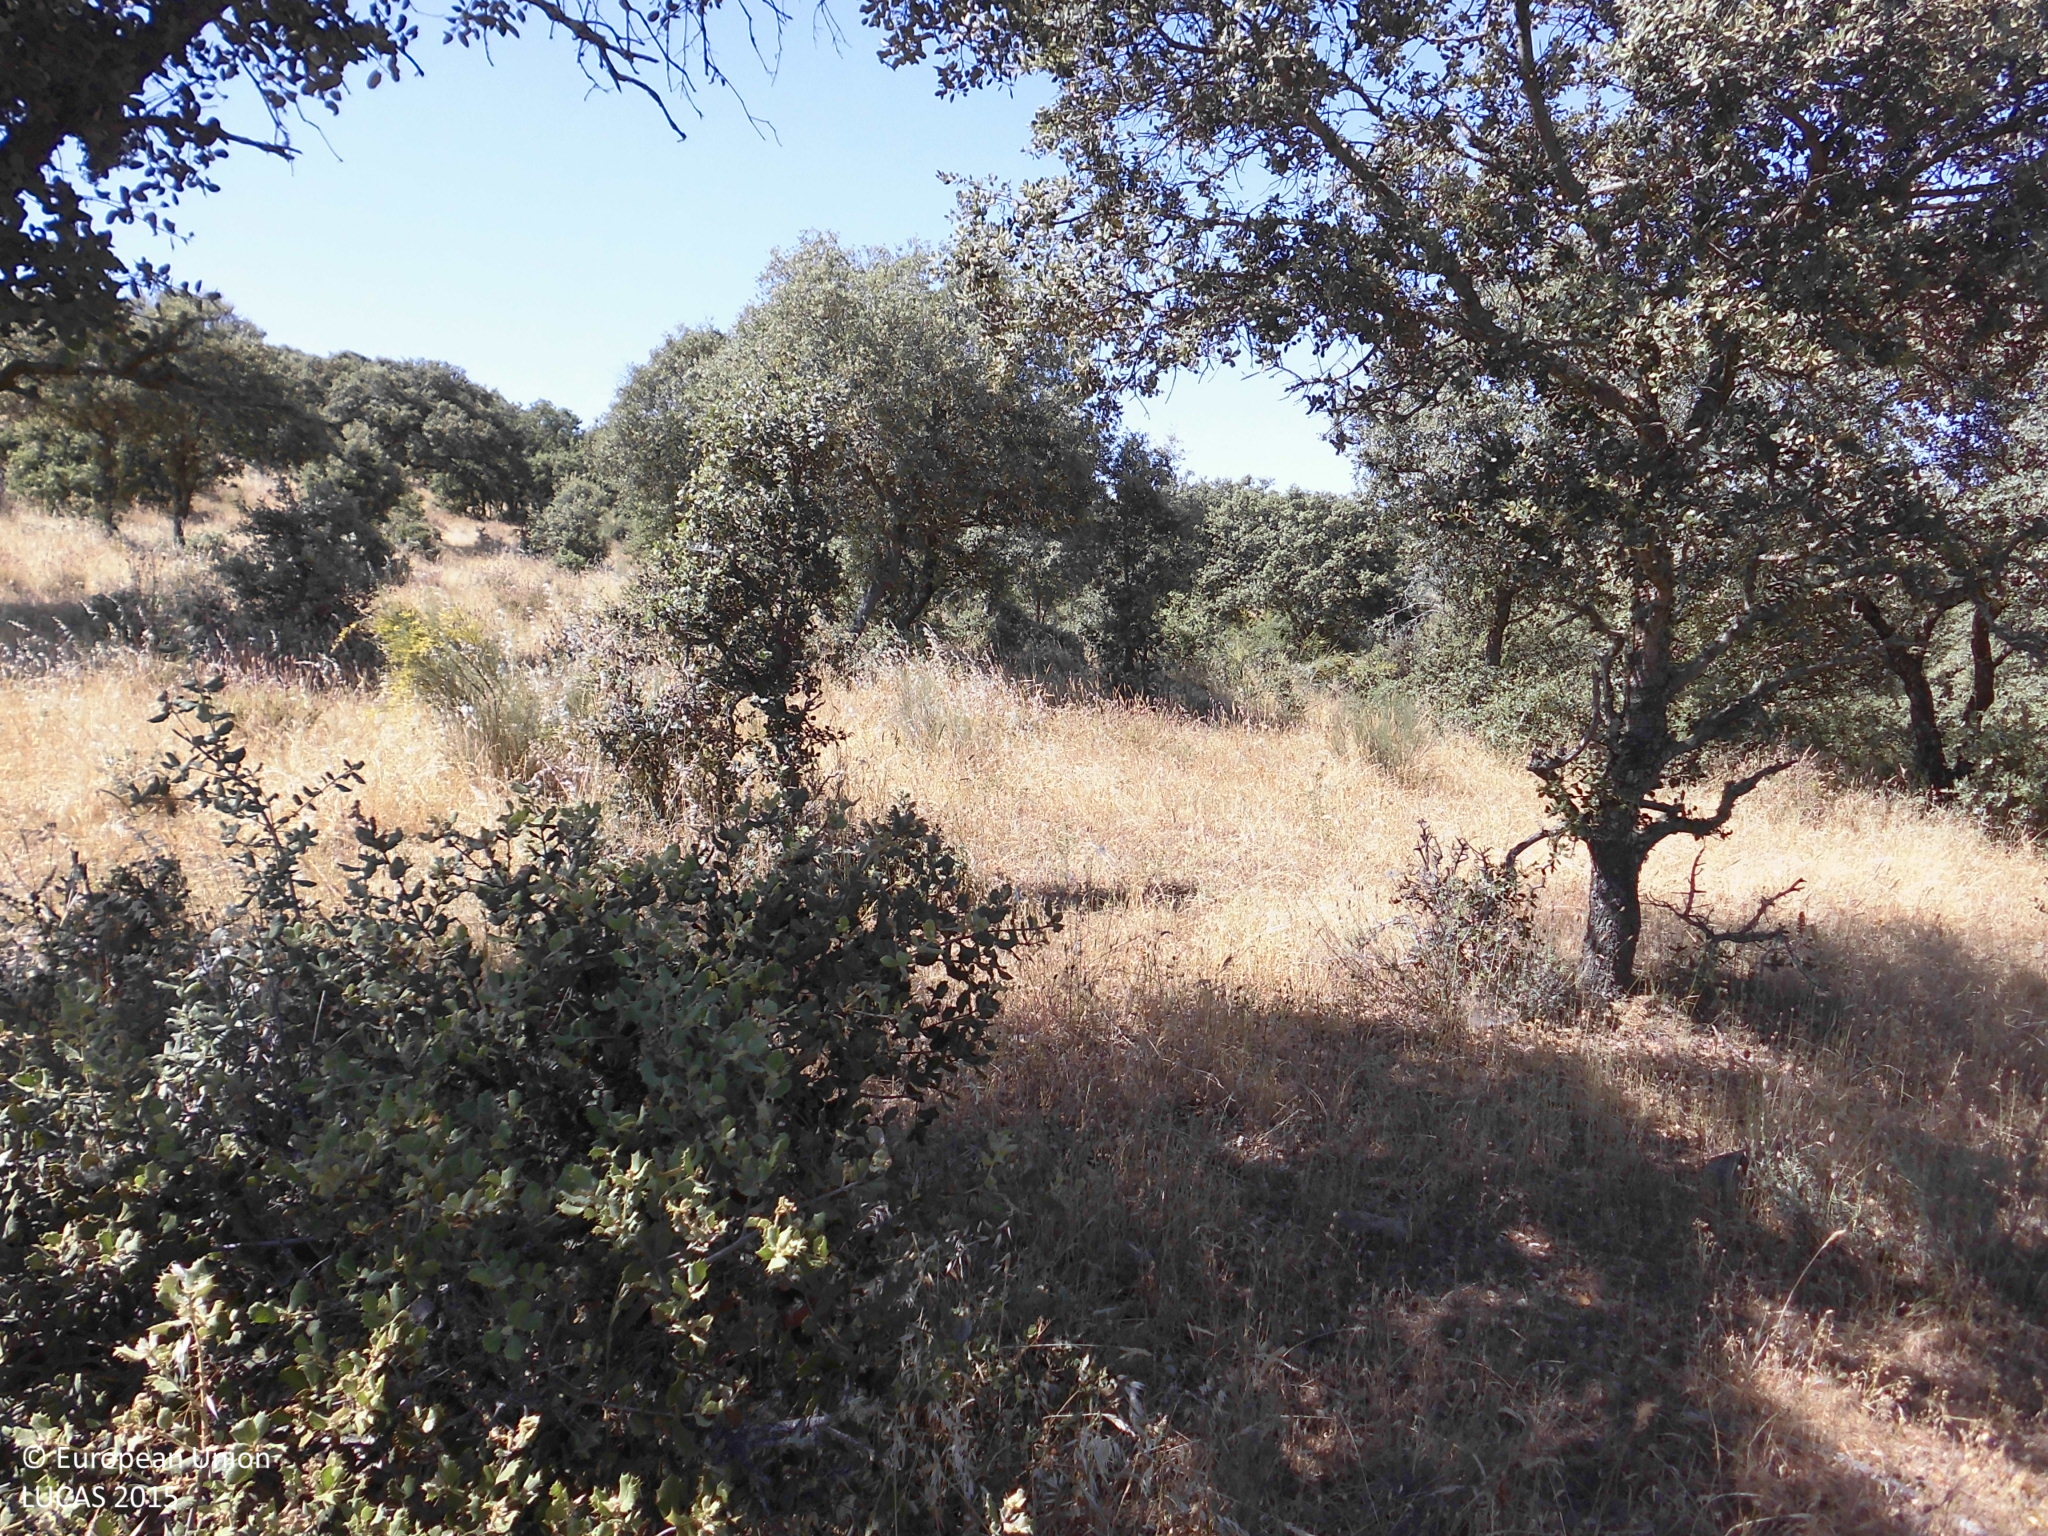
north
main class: Woodland
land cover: Broadleaved woodland
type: broadleaved evergreen forest
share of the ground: 25 - 50 %
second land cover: Grassland without tree/shrub cover
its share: > 75 %
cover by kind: herbaceous plants 55 %, broadleaved forest trees 30 %, shrubs 15 %
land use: Forestry
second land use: Agriculture (excluding fallow land and kitchen gardens)
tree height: > 5 m
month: May
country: ES
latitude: 39.3611
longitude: -6.0408
